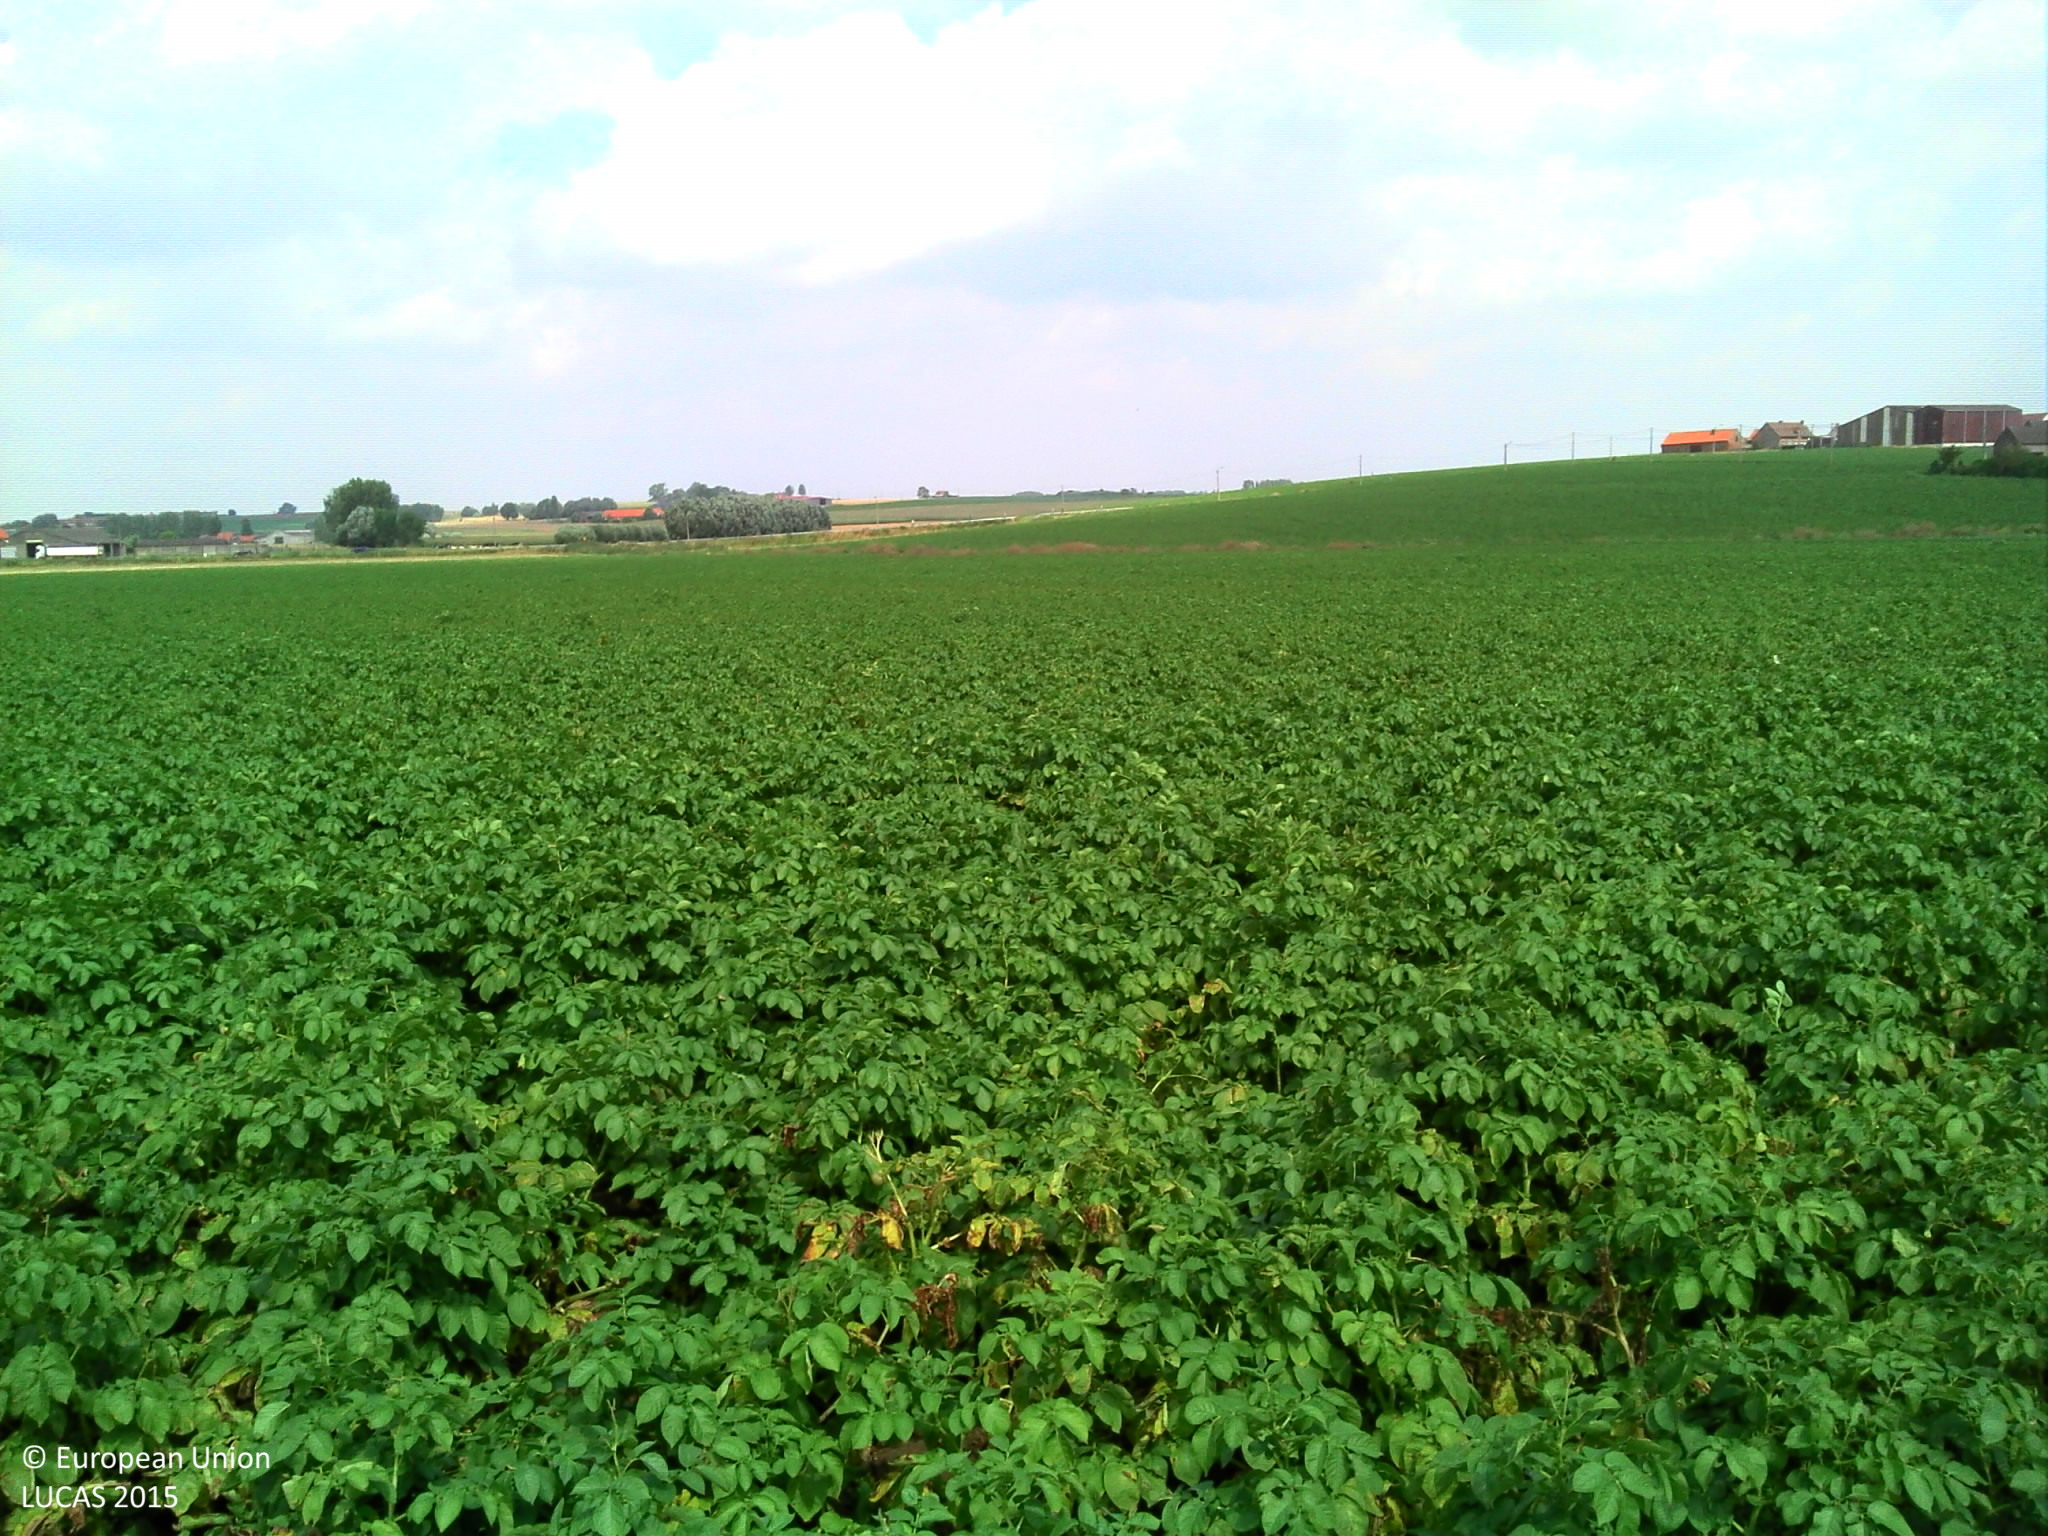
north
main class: Cropland
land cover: Potatoes
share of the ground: > 75 %
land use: Agriculture (excluding fallow land and kitchen gardens)
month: August
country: BE
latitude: 50.7545
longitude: 2.8593
